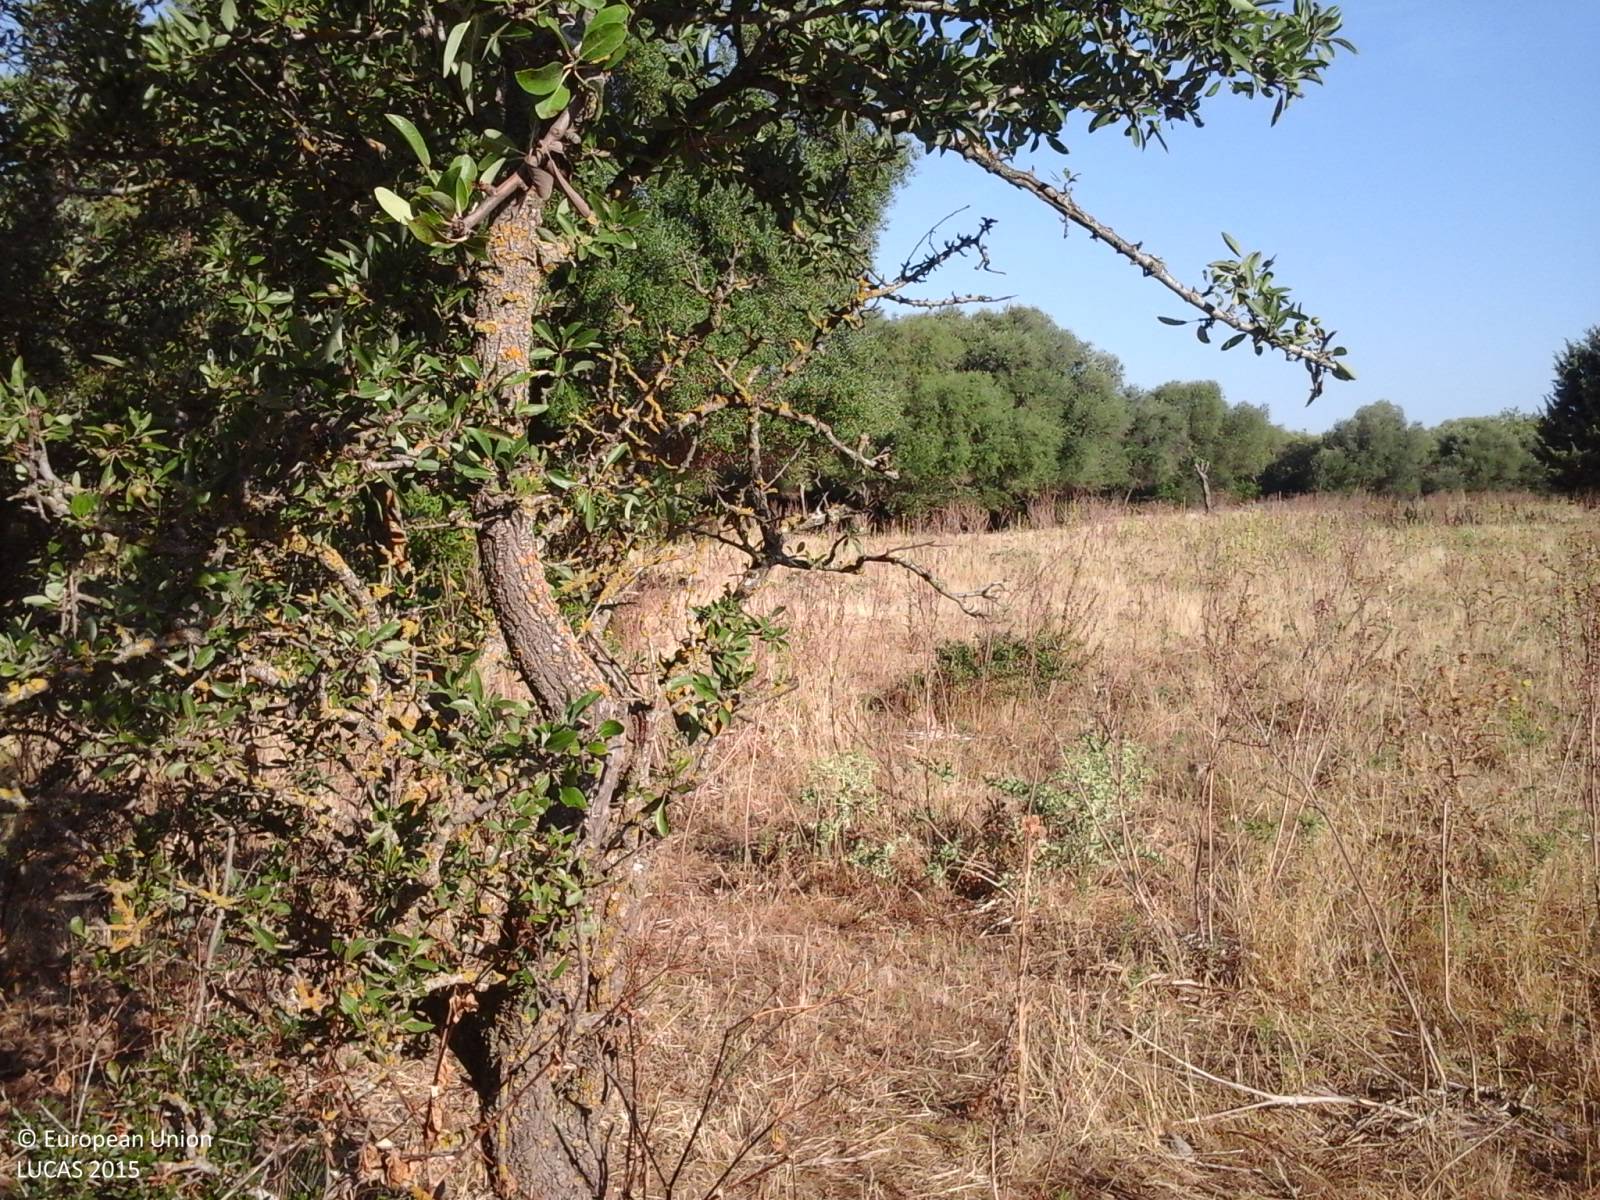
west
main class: Grassland
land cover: Grassland with sparse tree/shrub cover
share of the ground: 50 - 75 %
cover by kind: herbaceous plants 75 %, shrubs 10 %, unconsolidated bare surface 10 %, broadleaved forest trees 5 %
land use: Agriculture (excluding fallow land and kitchen gardens)
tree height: < 5 m
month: June
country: IT
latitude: 40.9127
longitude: 8.9010
